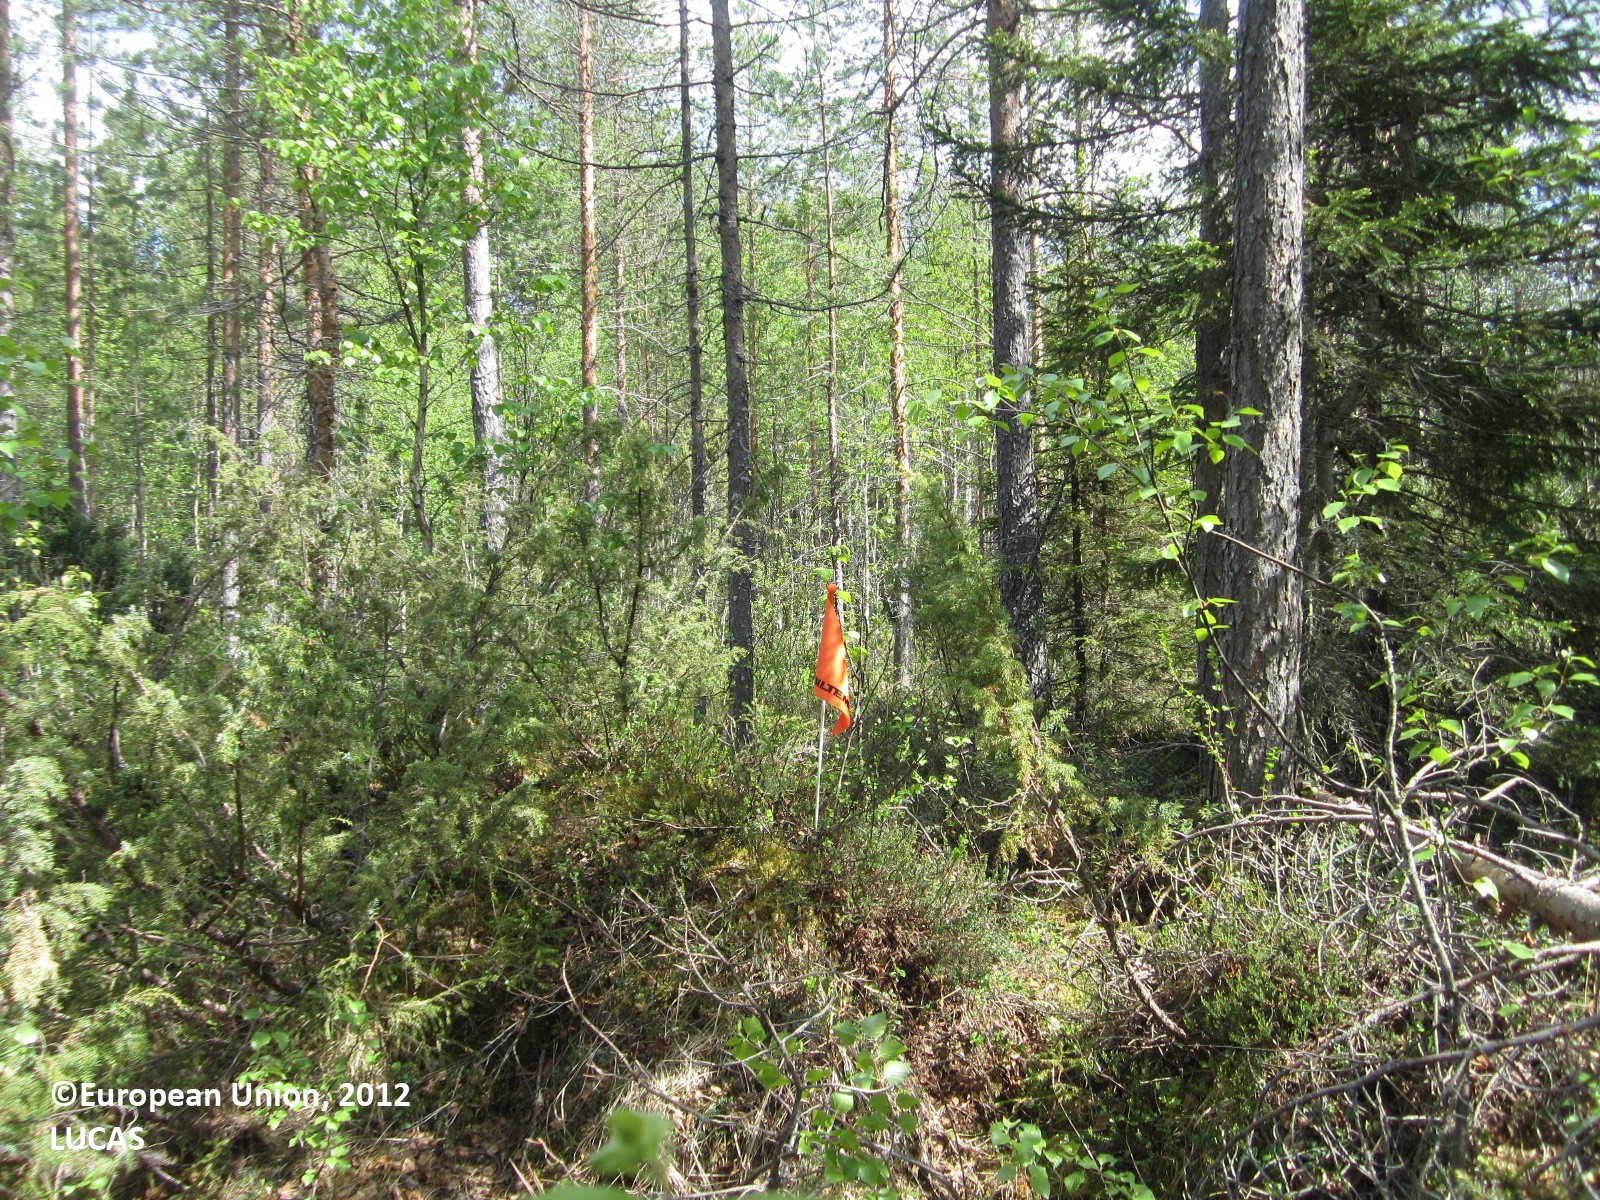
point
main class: Woodland
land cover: Other coniferous woodland
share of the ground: 50 - 75 %
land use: Forestry
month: June
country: FI
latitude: 64.5903
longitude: 28.7527
